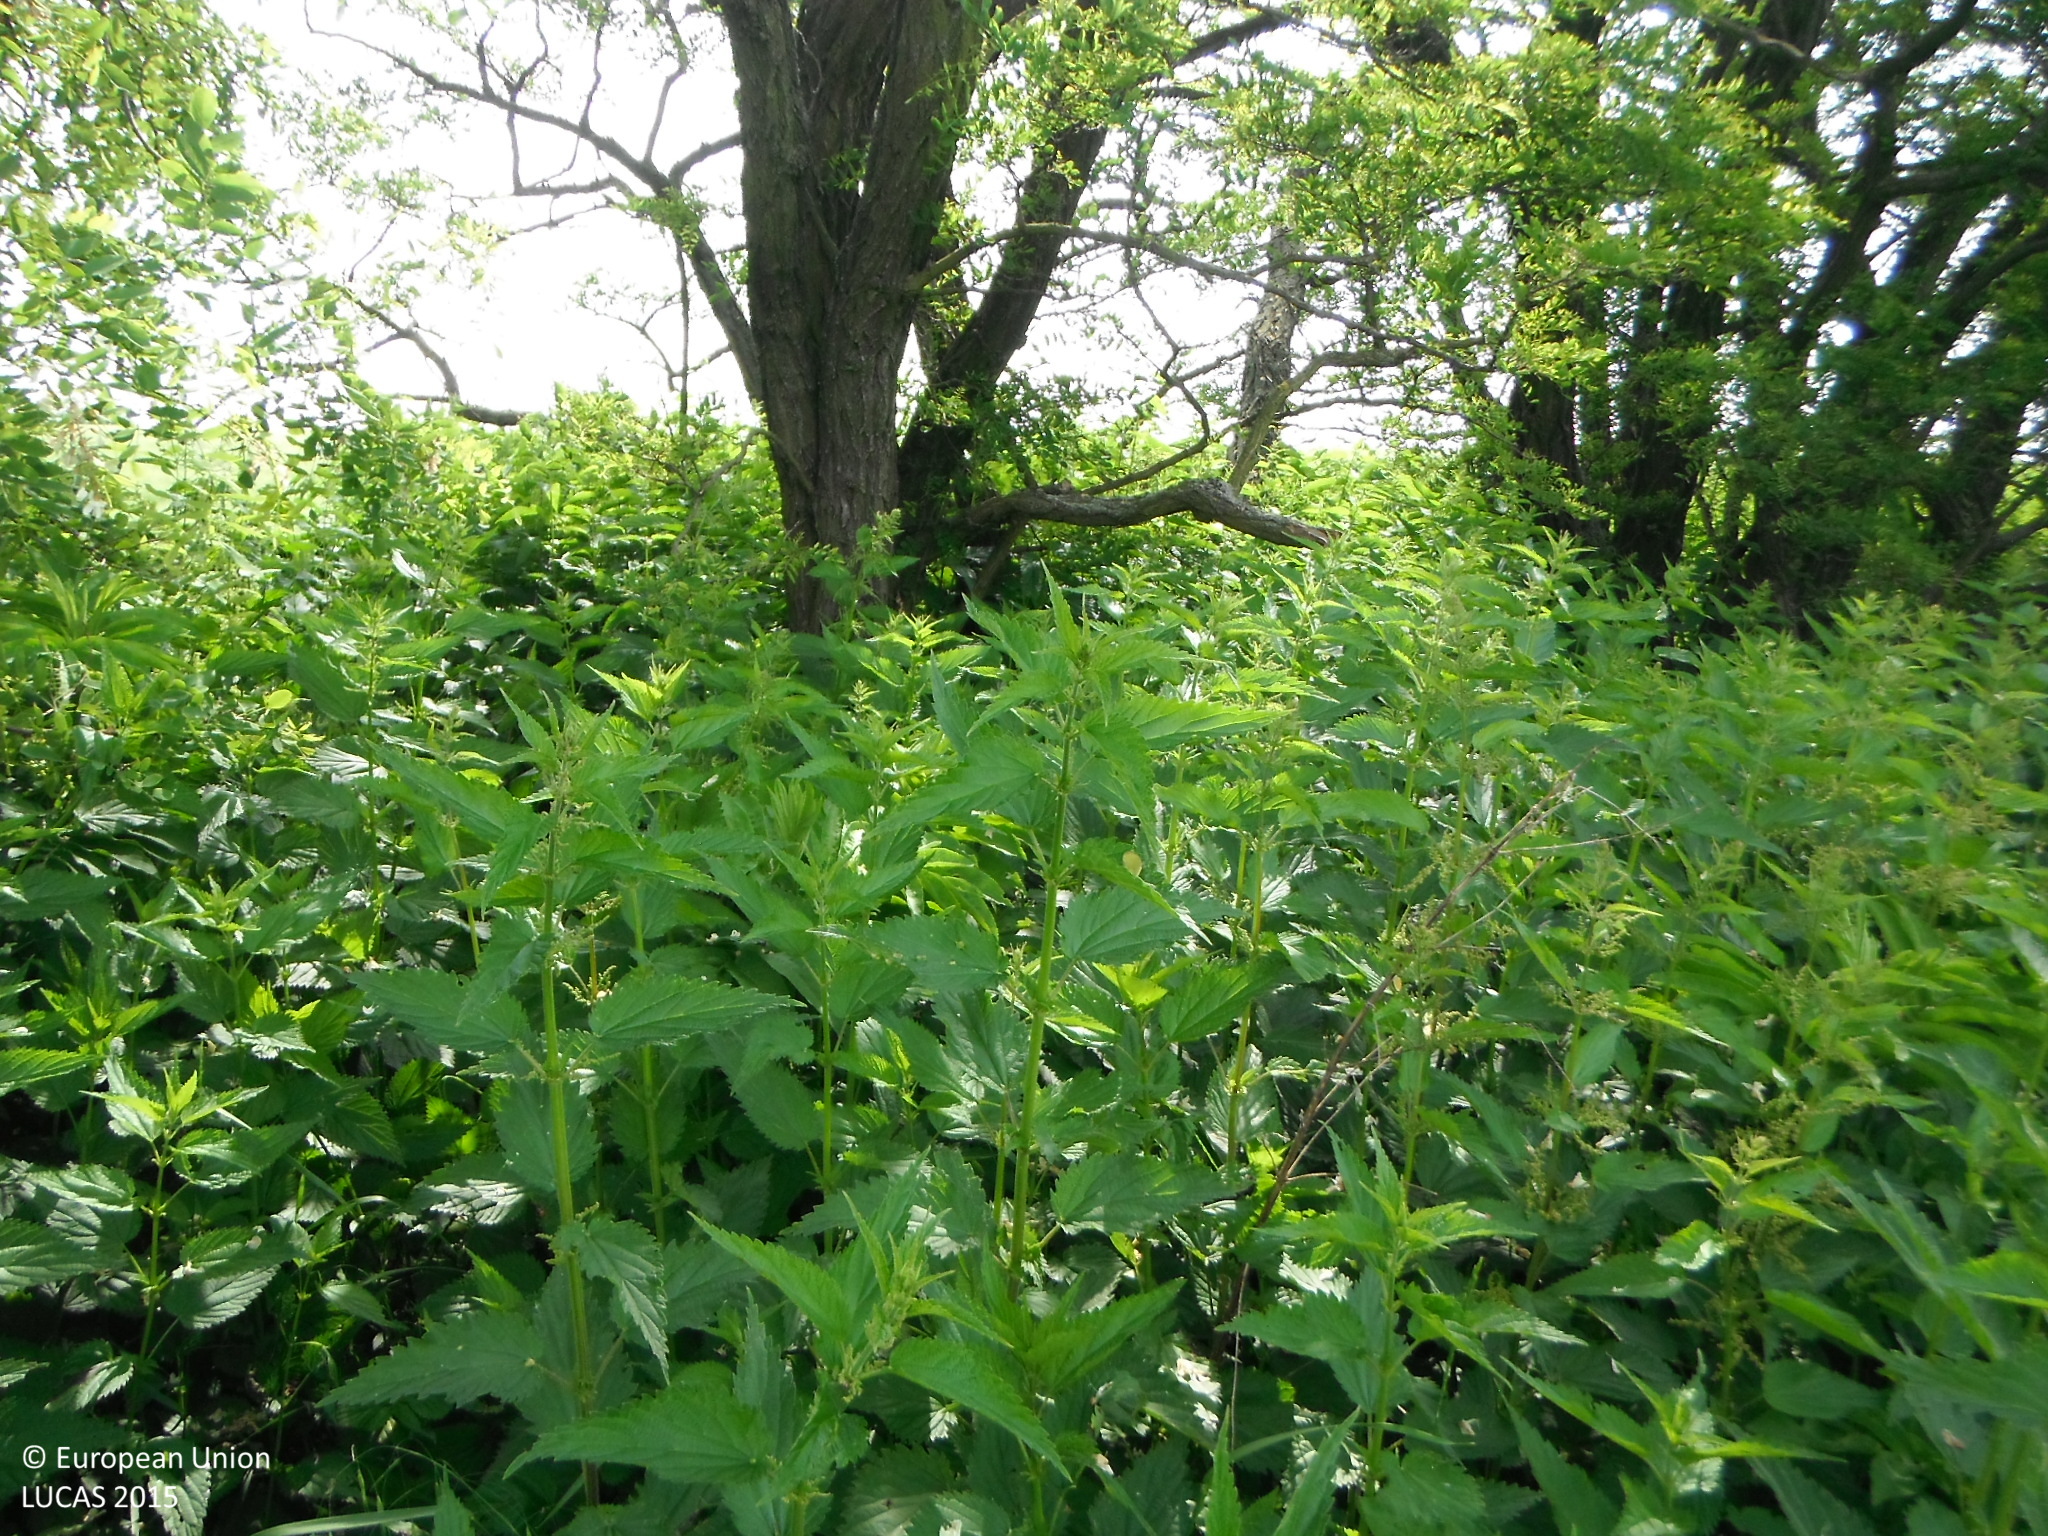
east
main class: Cropland
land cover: Rape and turnip rape
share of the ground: > 75 %
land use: Agriculture (excluding fallow land and kitchen gardens)
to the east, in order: Rape and turnip rape; Shruby margins; Broadleaved woodland; Grass margins; Common wheat
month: June
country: SK
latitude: 48.2381
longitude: 18.2684
